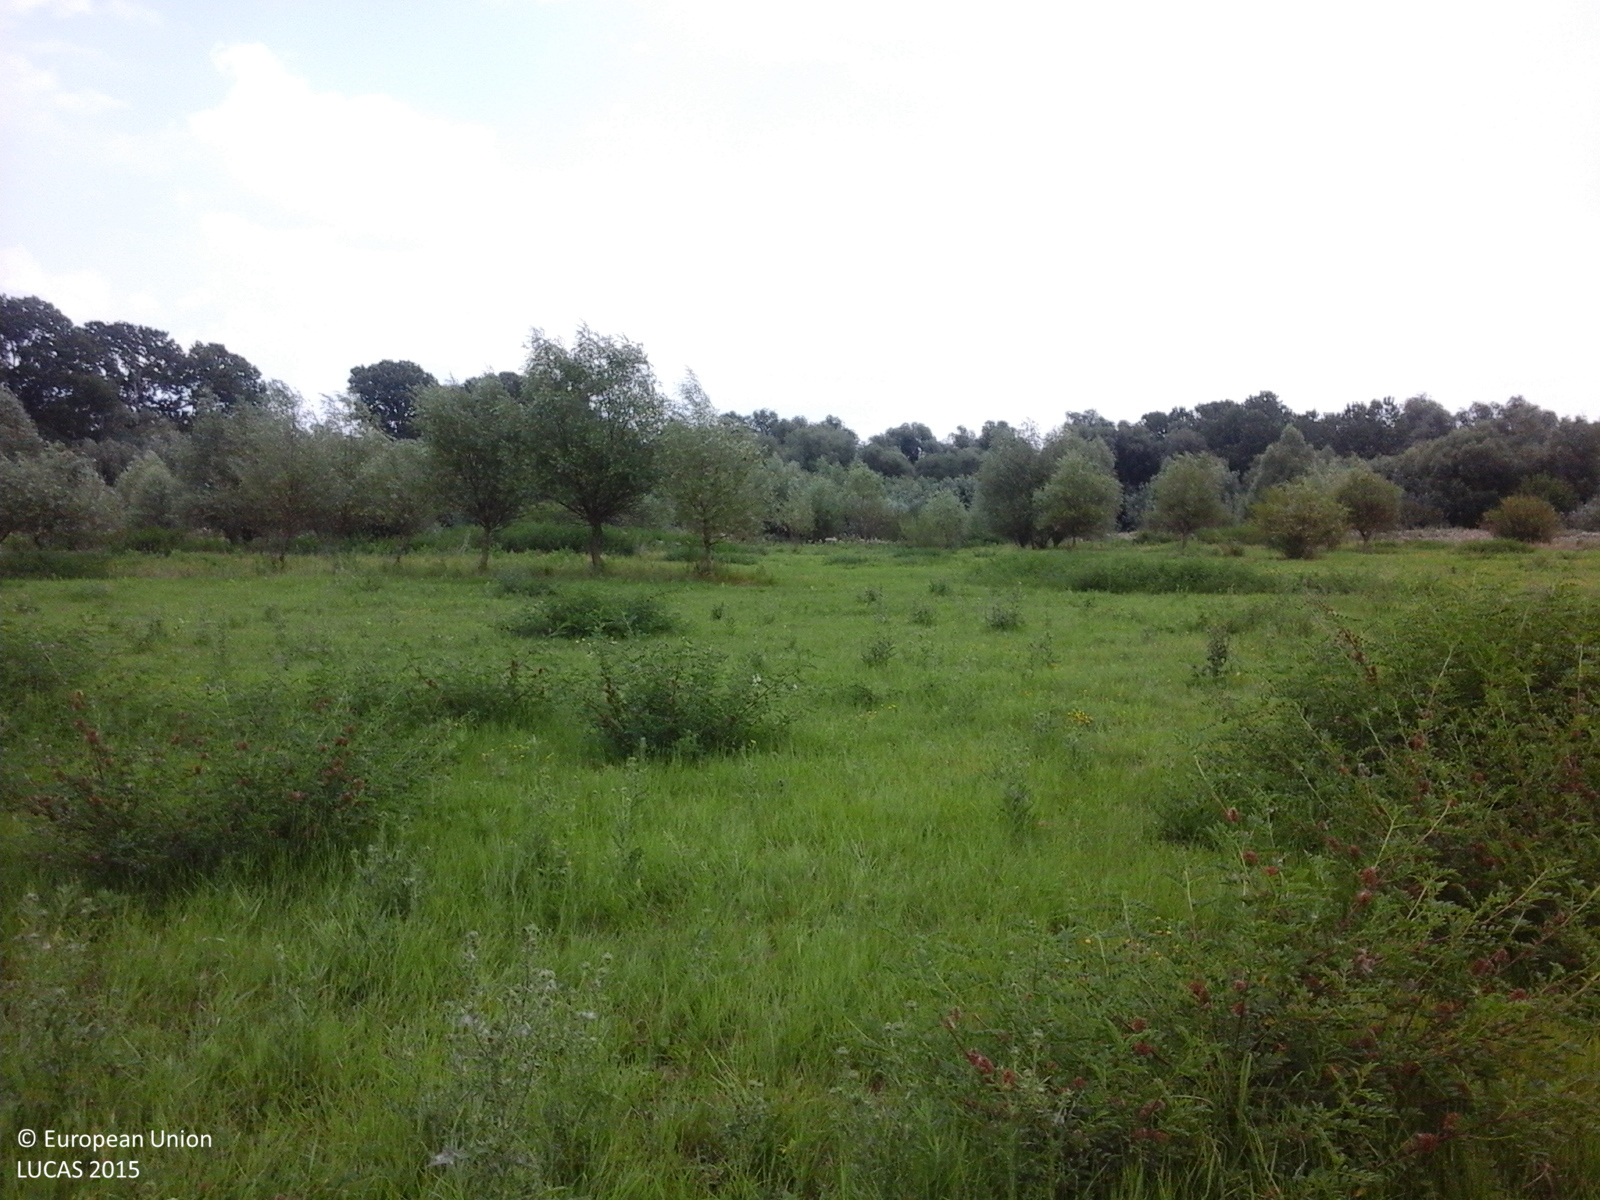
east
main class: Grassland
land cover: Spontaneously vegetated surfaces
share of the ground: > 75 %
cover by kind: herbaceous plants 100 %
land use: Agriculture (excluding fallow land and kitchen gardens)
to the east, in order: Spontaneously vegetated surfaces; Grassland with sparse tree/shrub cover; Spontaneously vegetated surfaces; Inland fresh running water; Broadleaved woodland
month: July
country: RO
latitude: 46.0441
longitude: 28.1013
